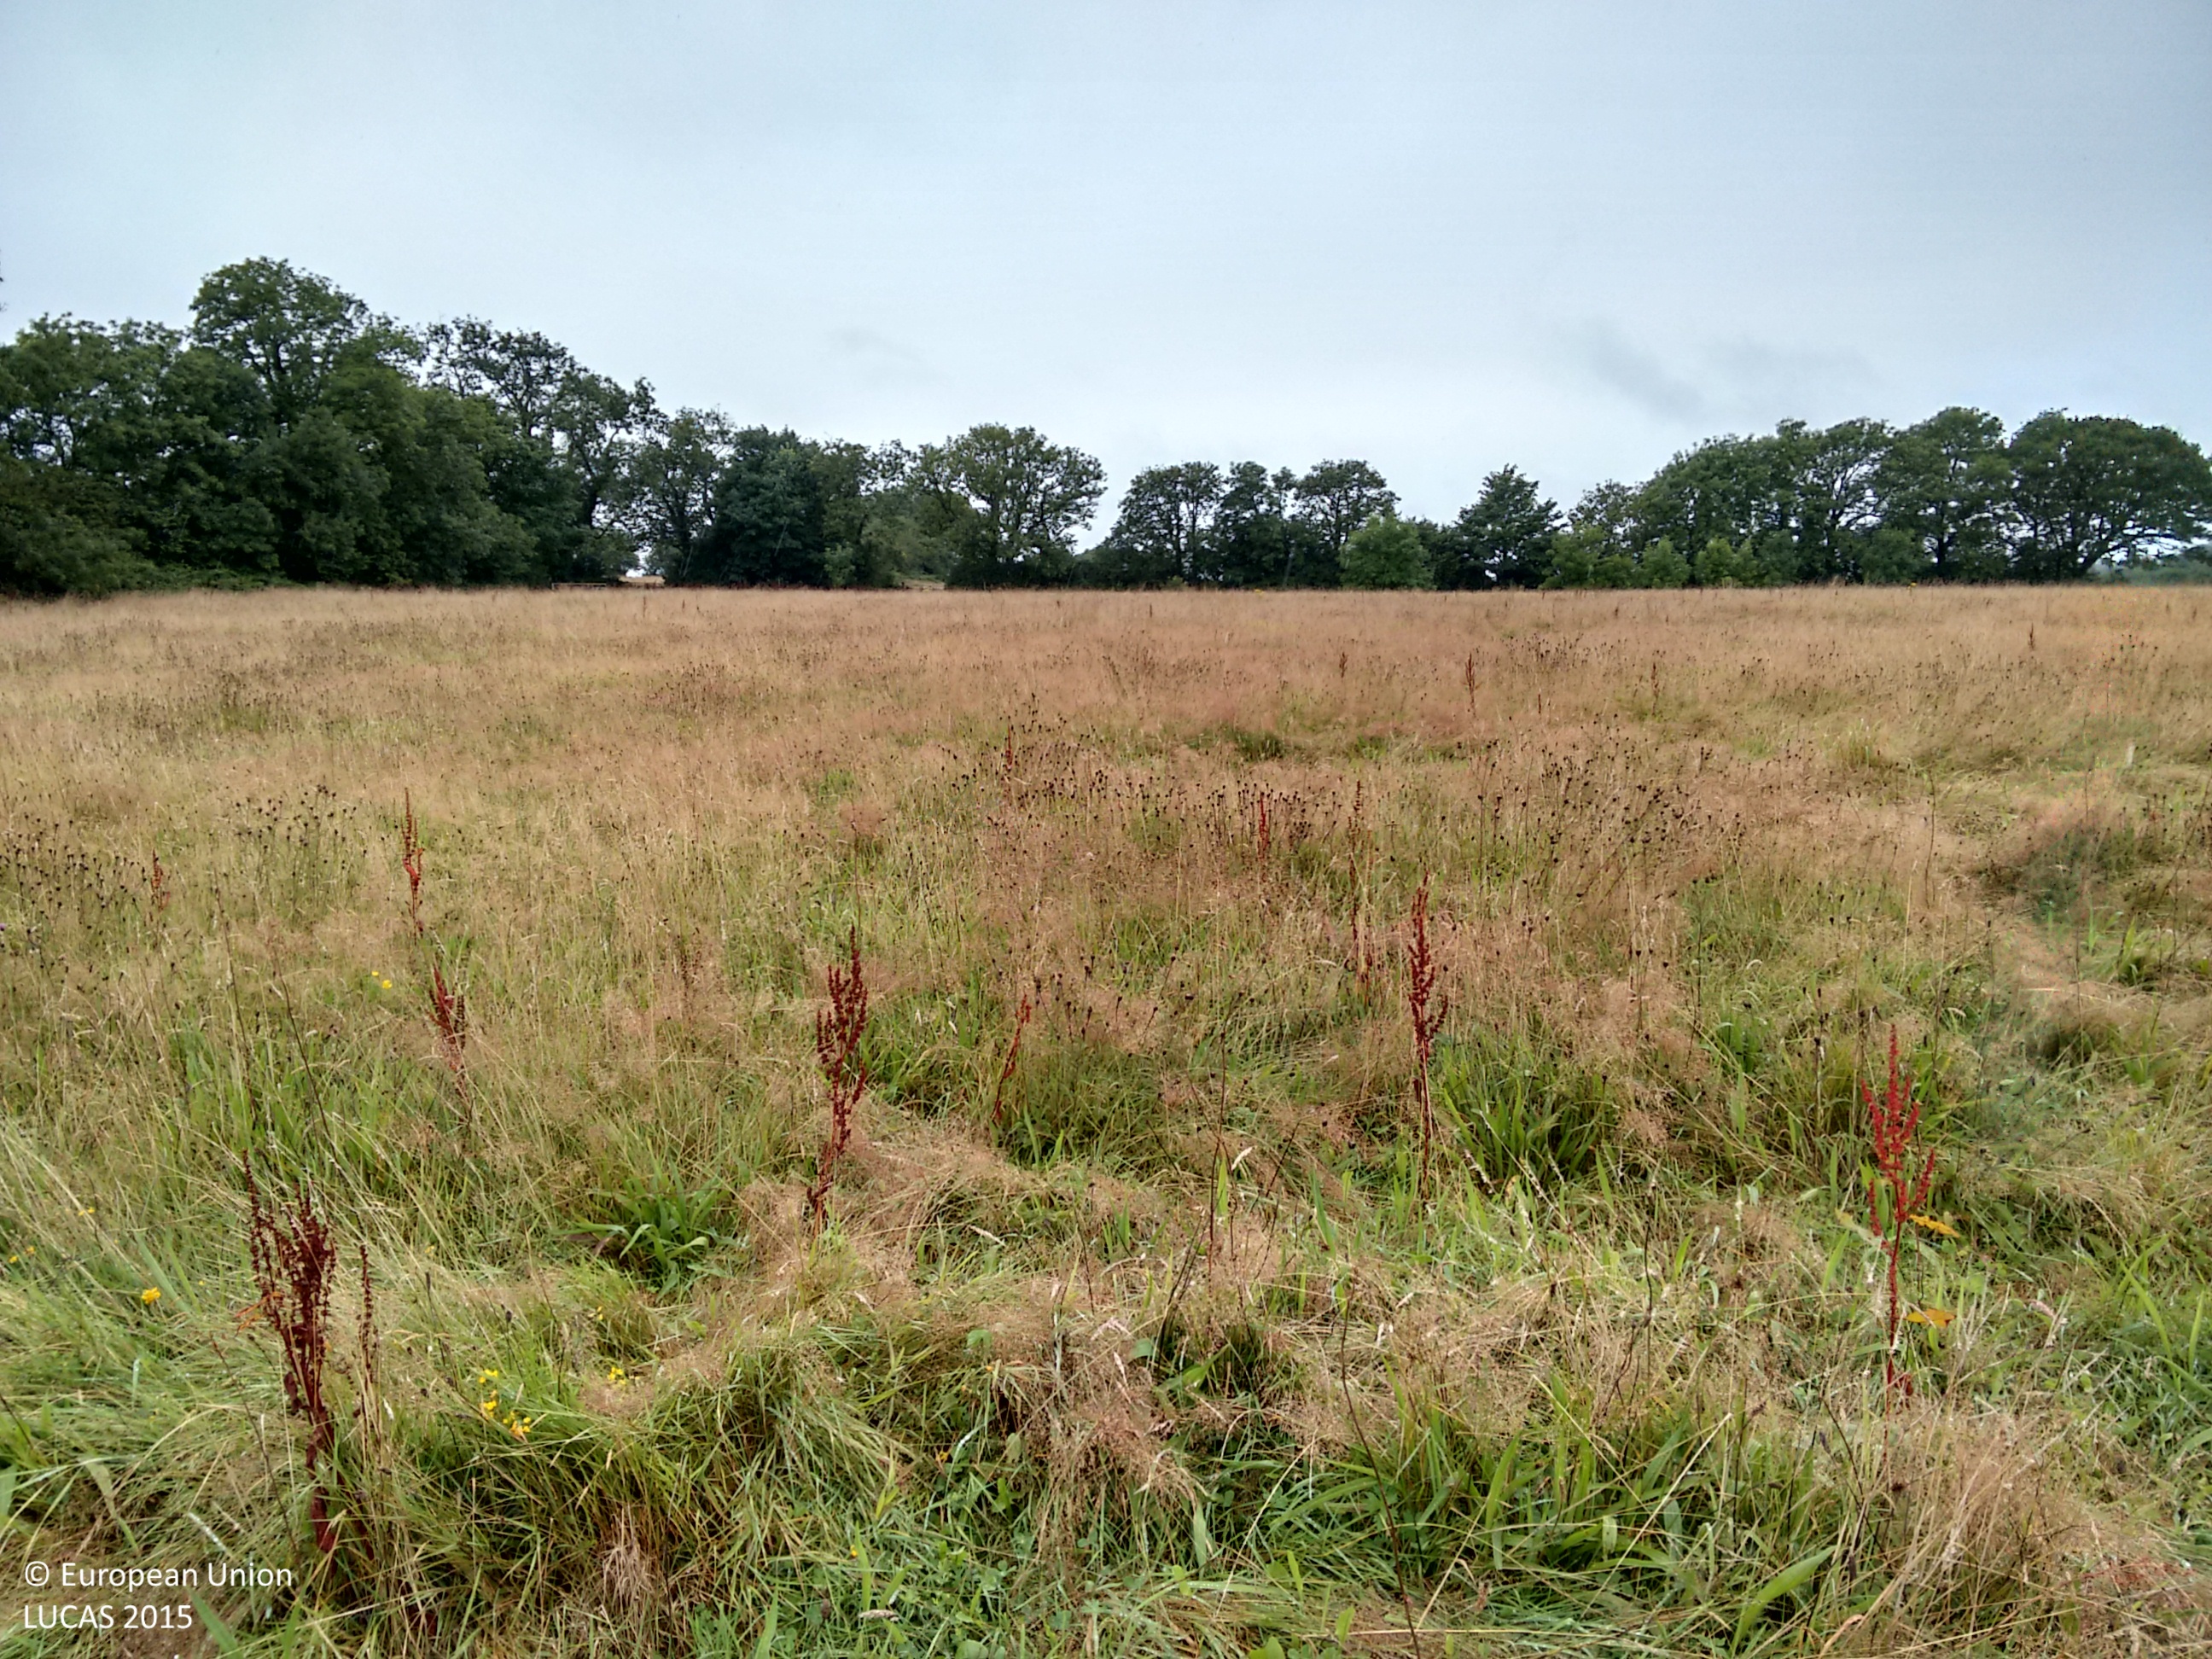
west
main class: Grassland
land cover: Grassland without tree/shrub cover
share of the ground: > 75 %
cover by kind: herbaceous plants 100 %
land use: Agriculture (excluding fallow land and kitchen gardens)
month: August
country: GB
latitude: 51.8218
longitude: -4.8391
